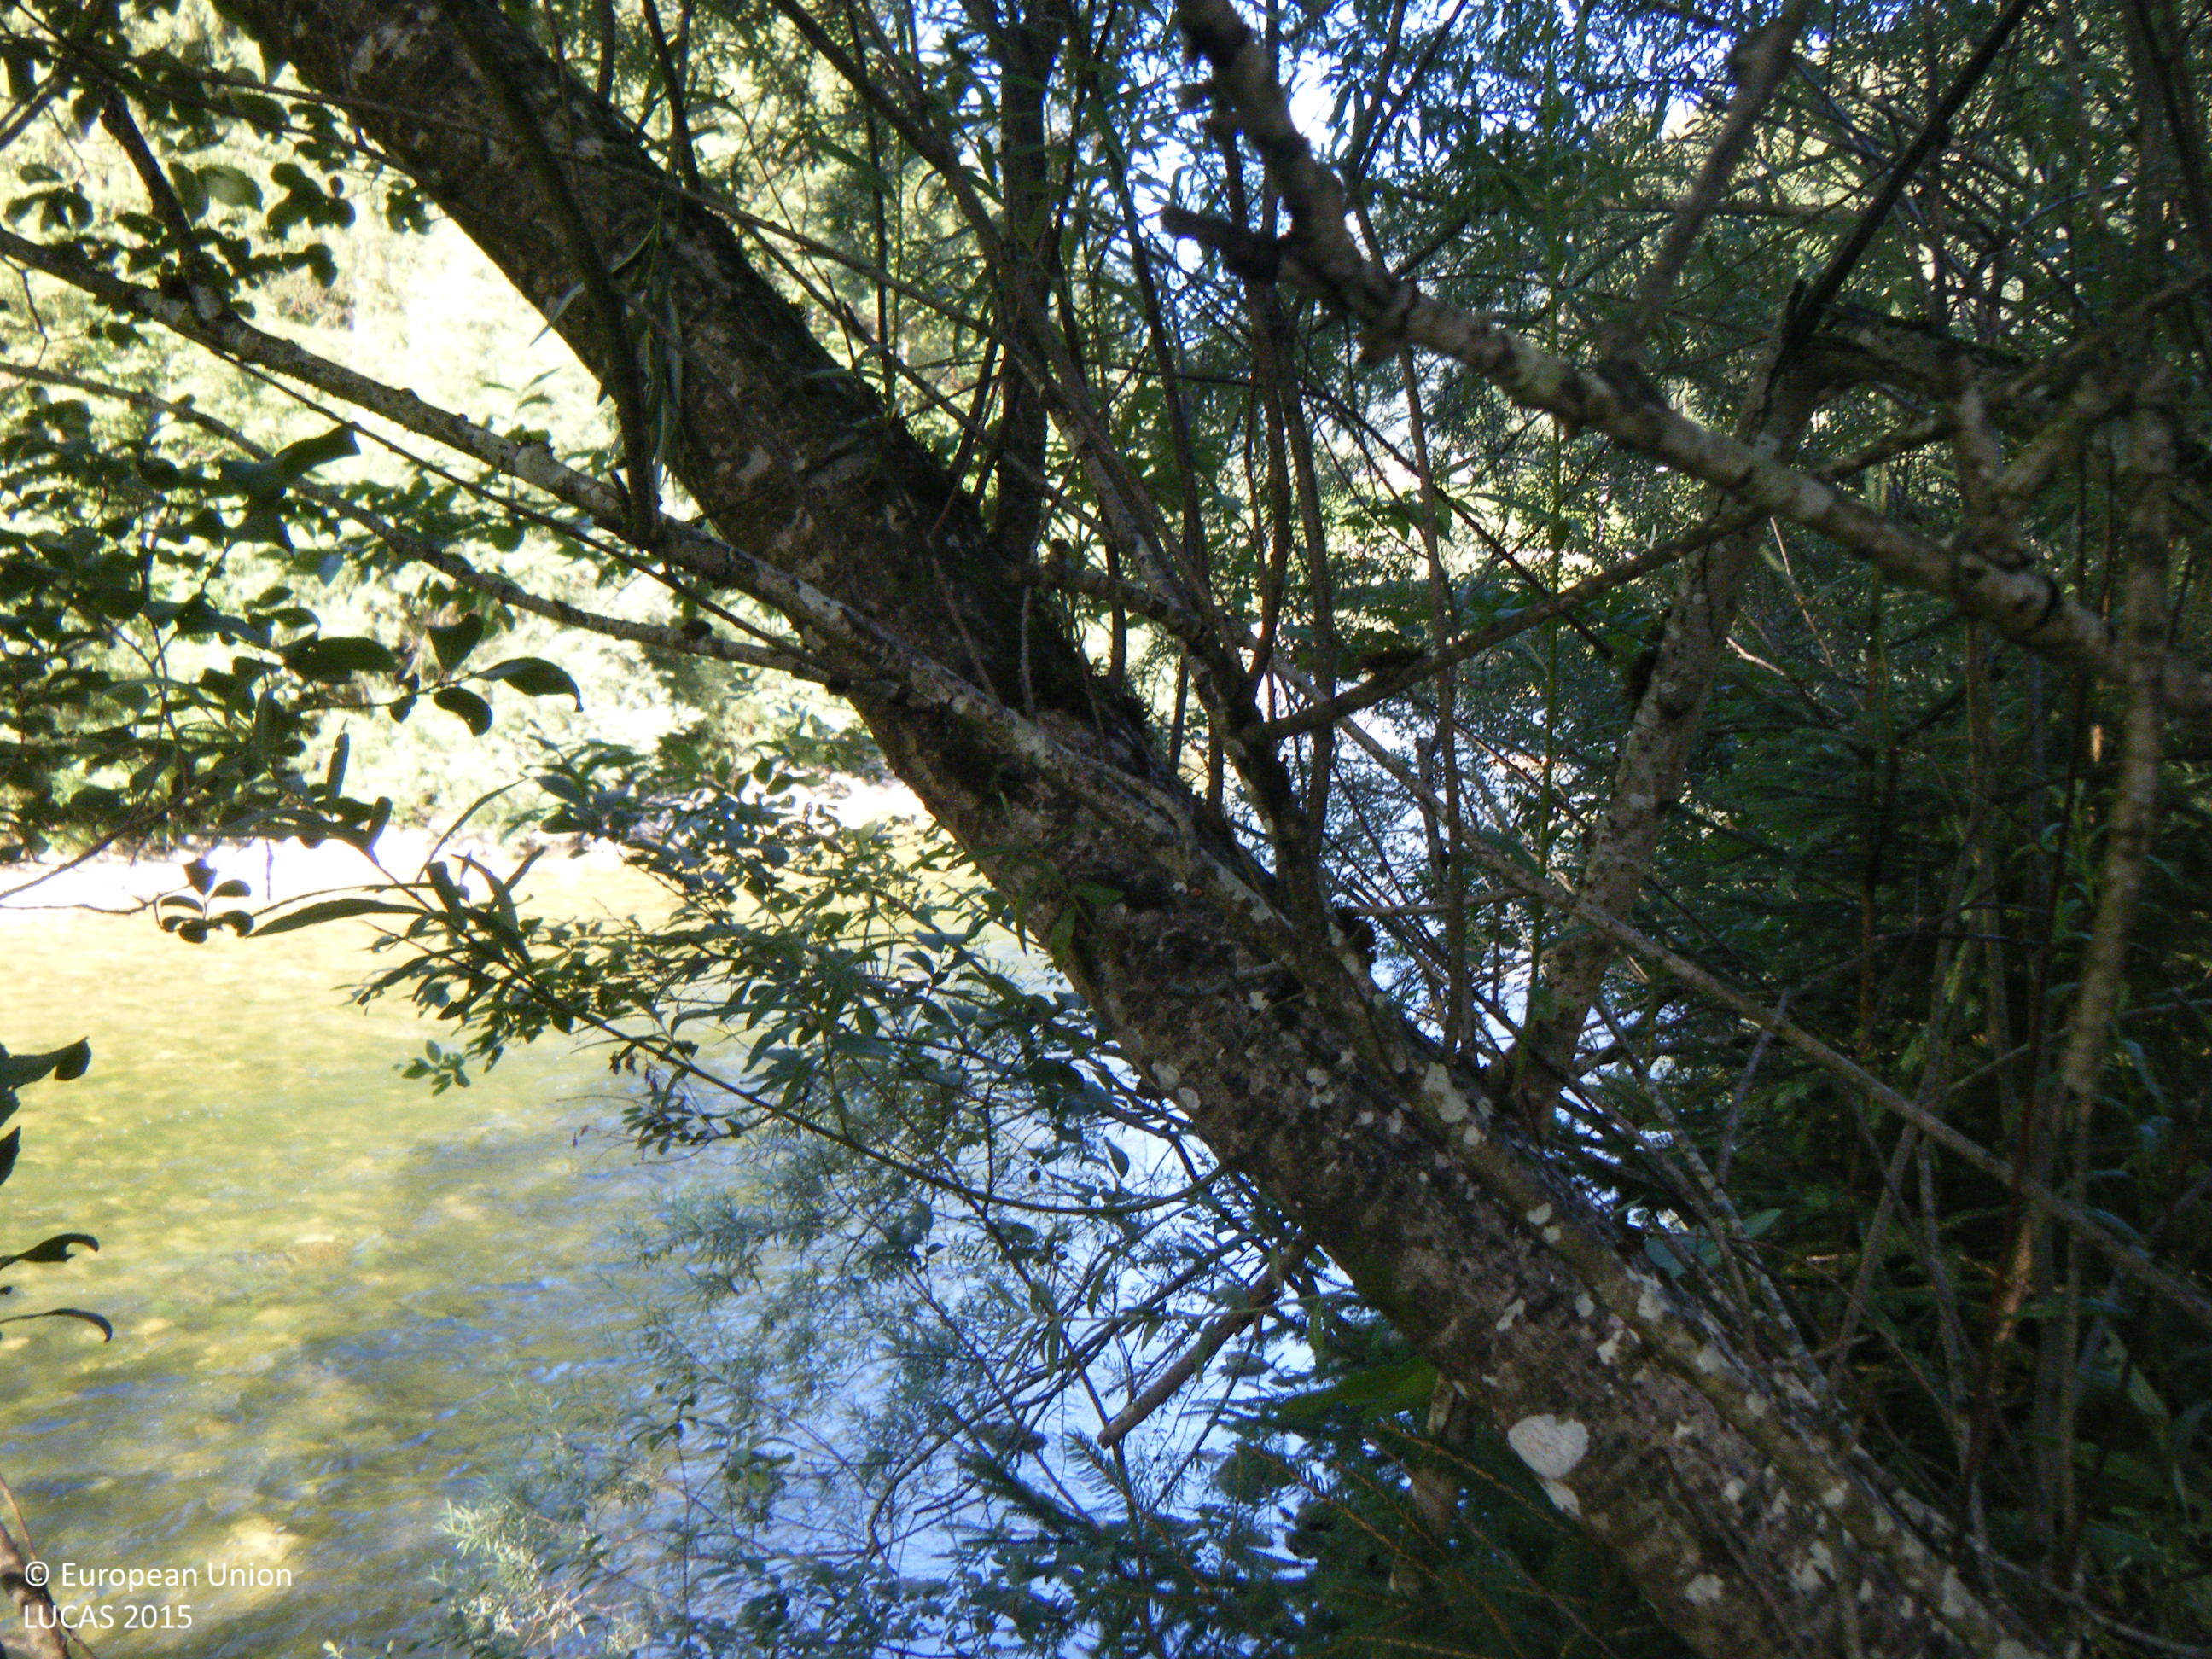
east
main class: Woodland
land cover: Spruce dominated mixed woodland
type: alpine coniferous forest
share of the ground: > 75 %
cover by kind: coniferous forest trees 70 %, broadleaved forest trees 25 %, herbaceous plants 5 %
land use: Forestry
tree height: > 5 m
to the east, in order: Spruce dominated mixed woodland; Spruce dominated coniferous woodland; Rocks and stones; Spruce dominated coniferous woodland; Artificial constructions; Inland fresh running water; Artificial constructions; Fences; Grass margins; Tracks; Broadleaved woodland
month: July
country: AT
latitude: 47.6009
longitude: 13.7627
